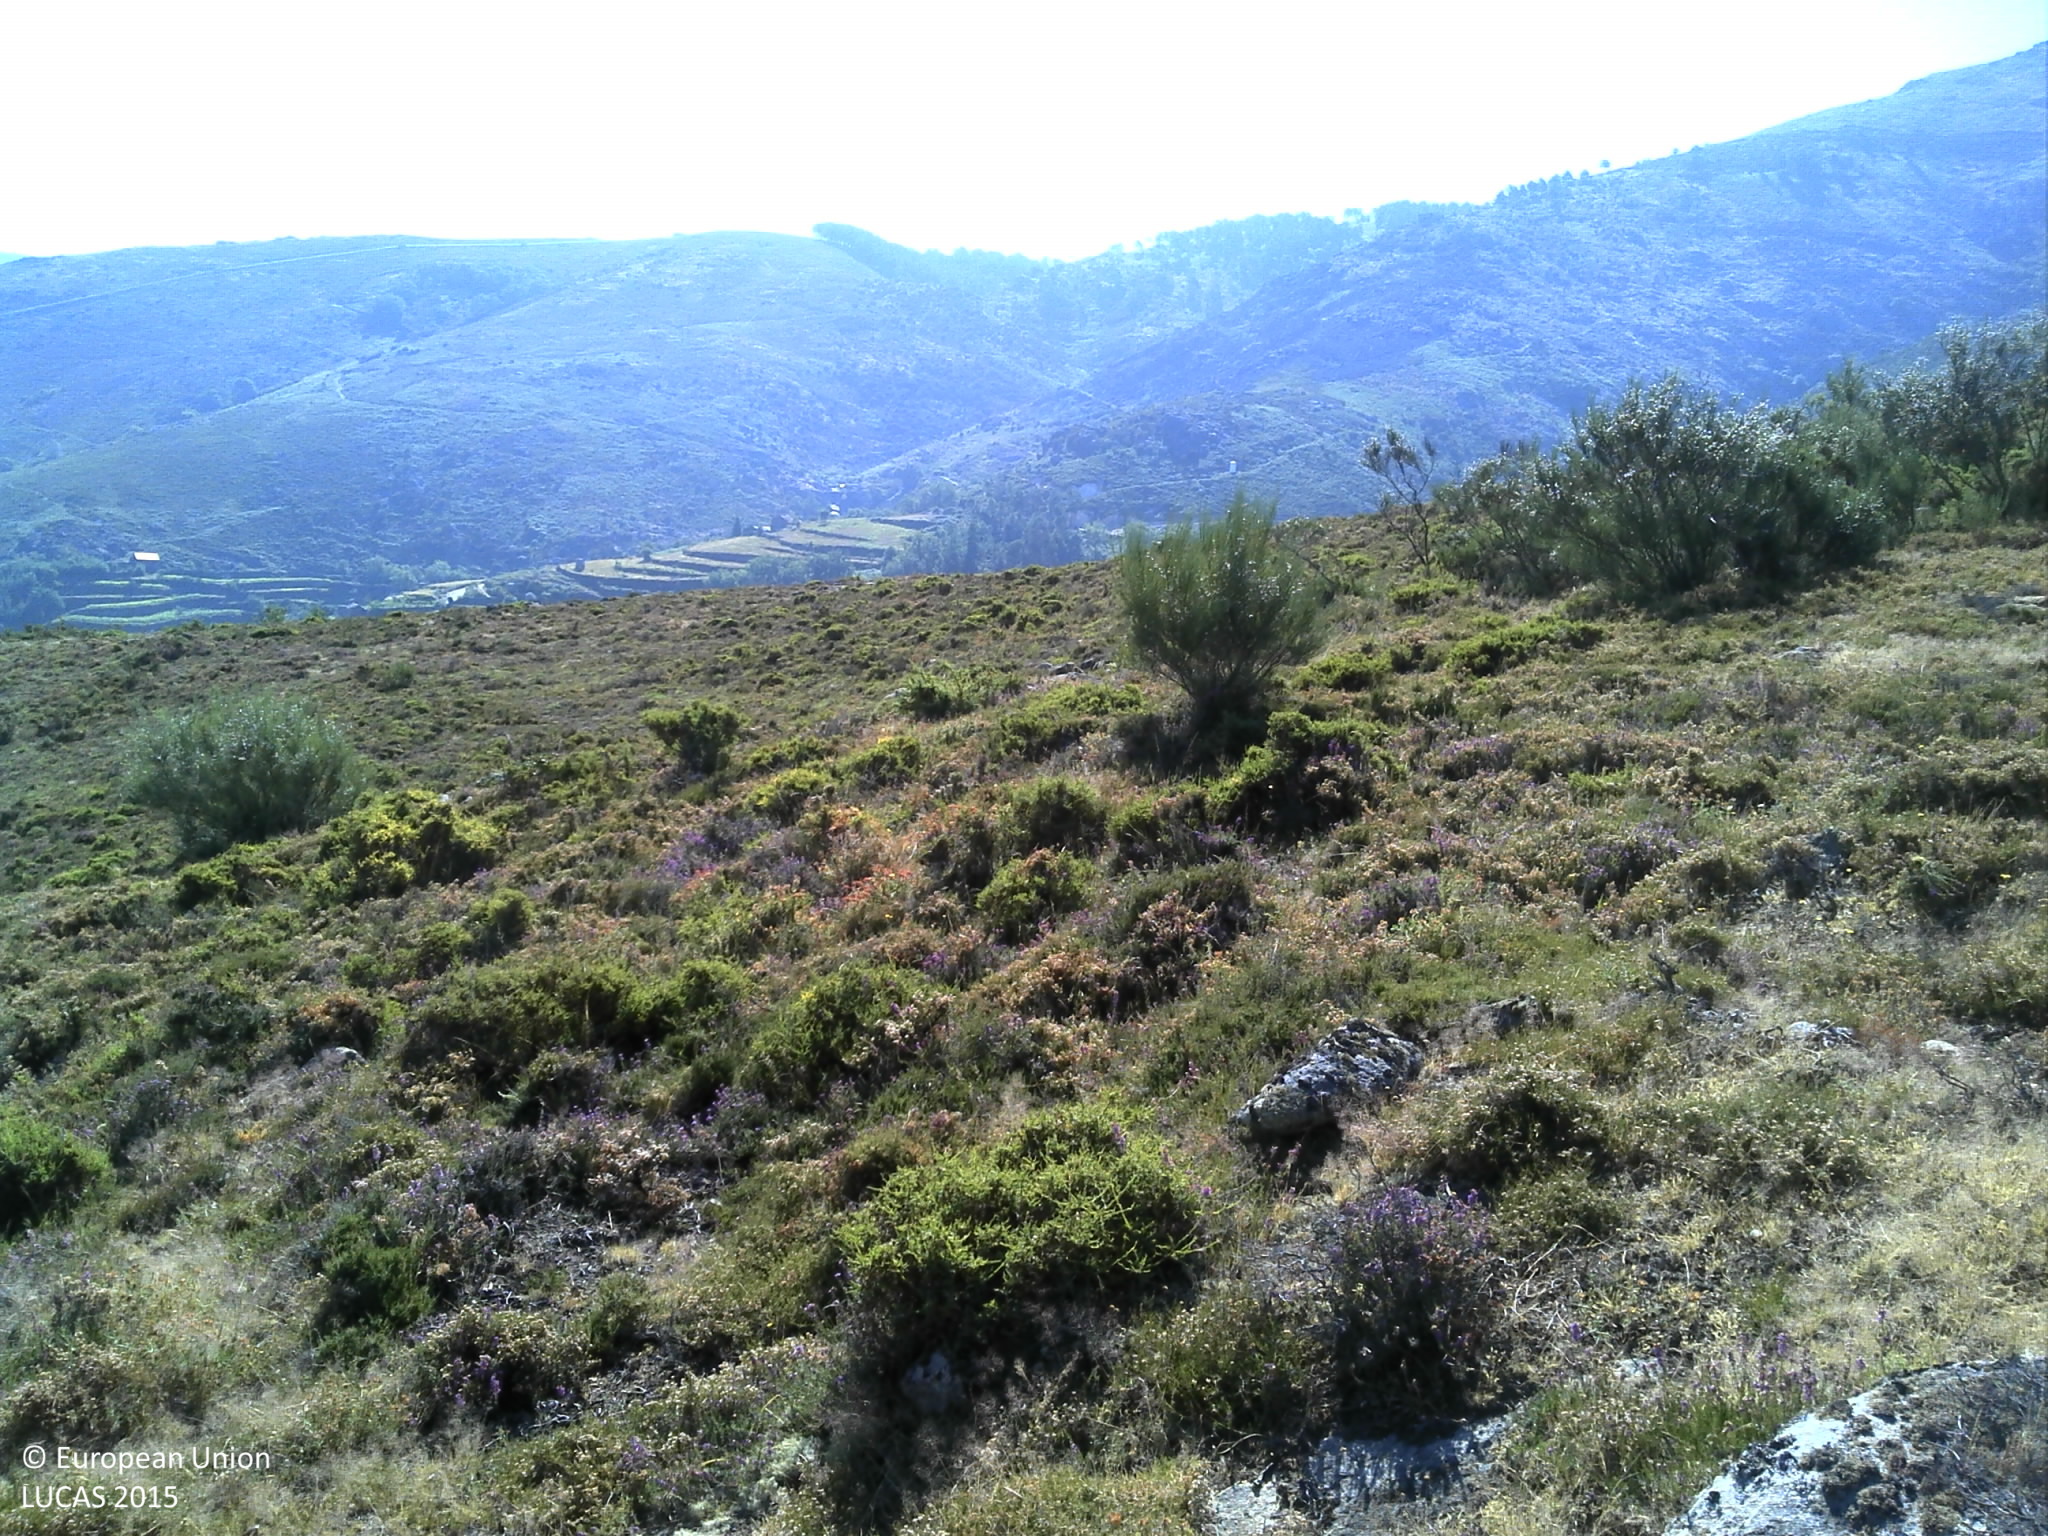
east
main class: Shrubland
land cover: Shrubland without tree cover
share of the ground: > 75 %
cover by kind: shrubs 90 %, consolidated bare surface 5 %, unconsolidated bare surface 5 %
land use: Agriculture (excluding fallow land and kitchen gardens)
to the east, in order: Shrubland without tree cover; Rocks and stones; Shrubland without tree cover; Rocks and stones; Shrubland without tree cover; Tracks; Shrubland without tree cover; Rocks and stones; Shrubland without tree cover; Broadleaved woodland; Arable land (only in case pi)
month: July
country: PT
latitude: 41.4472
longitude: -7.8141
